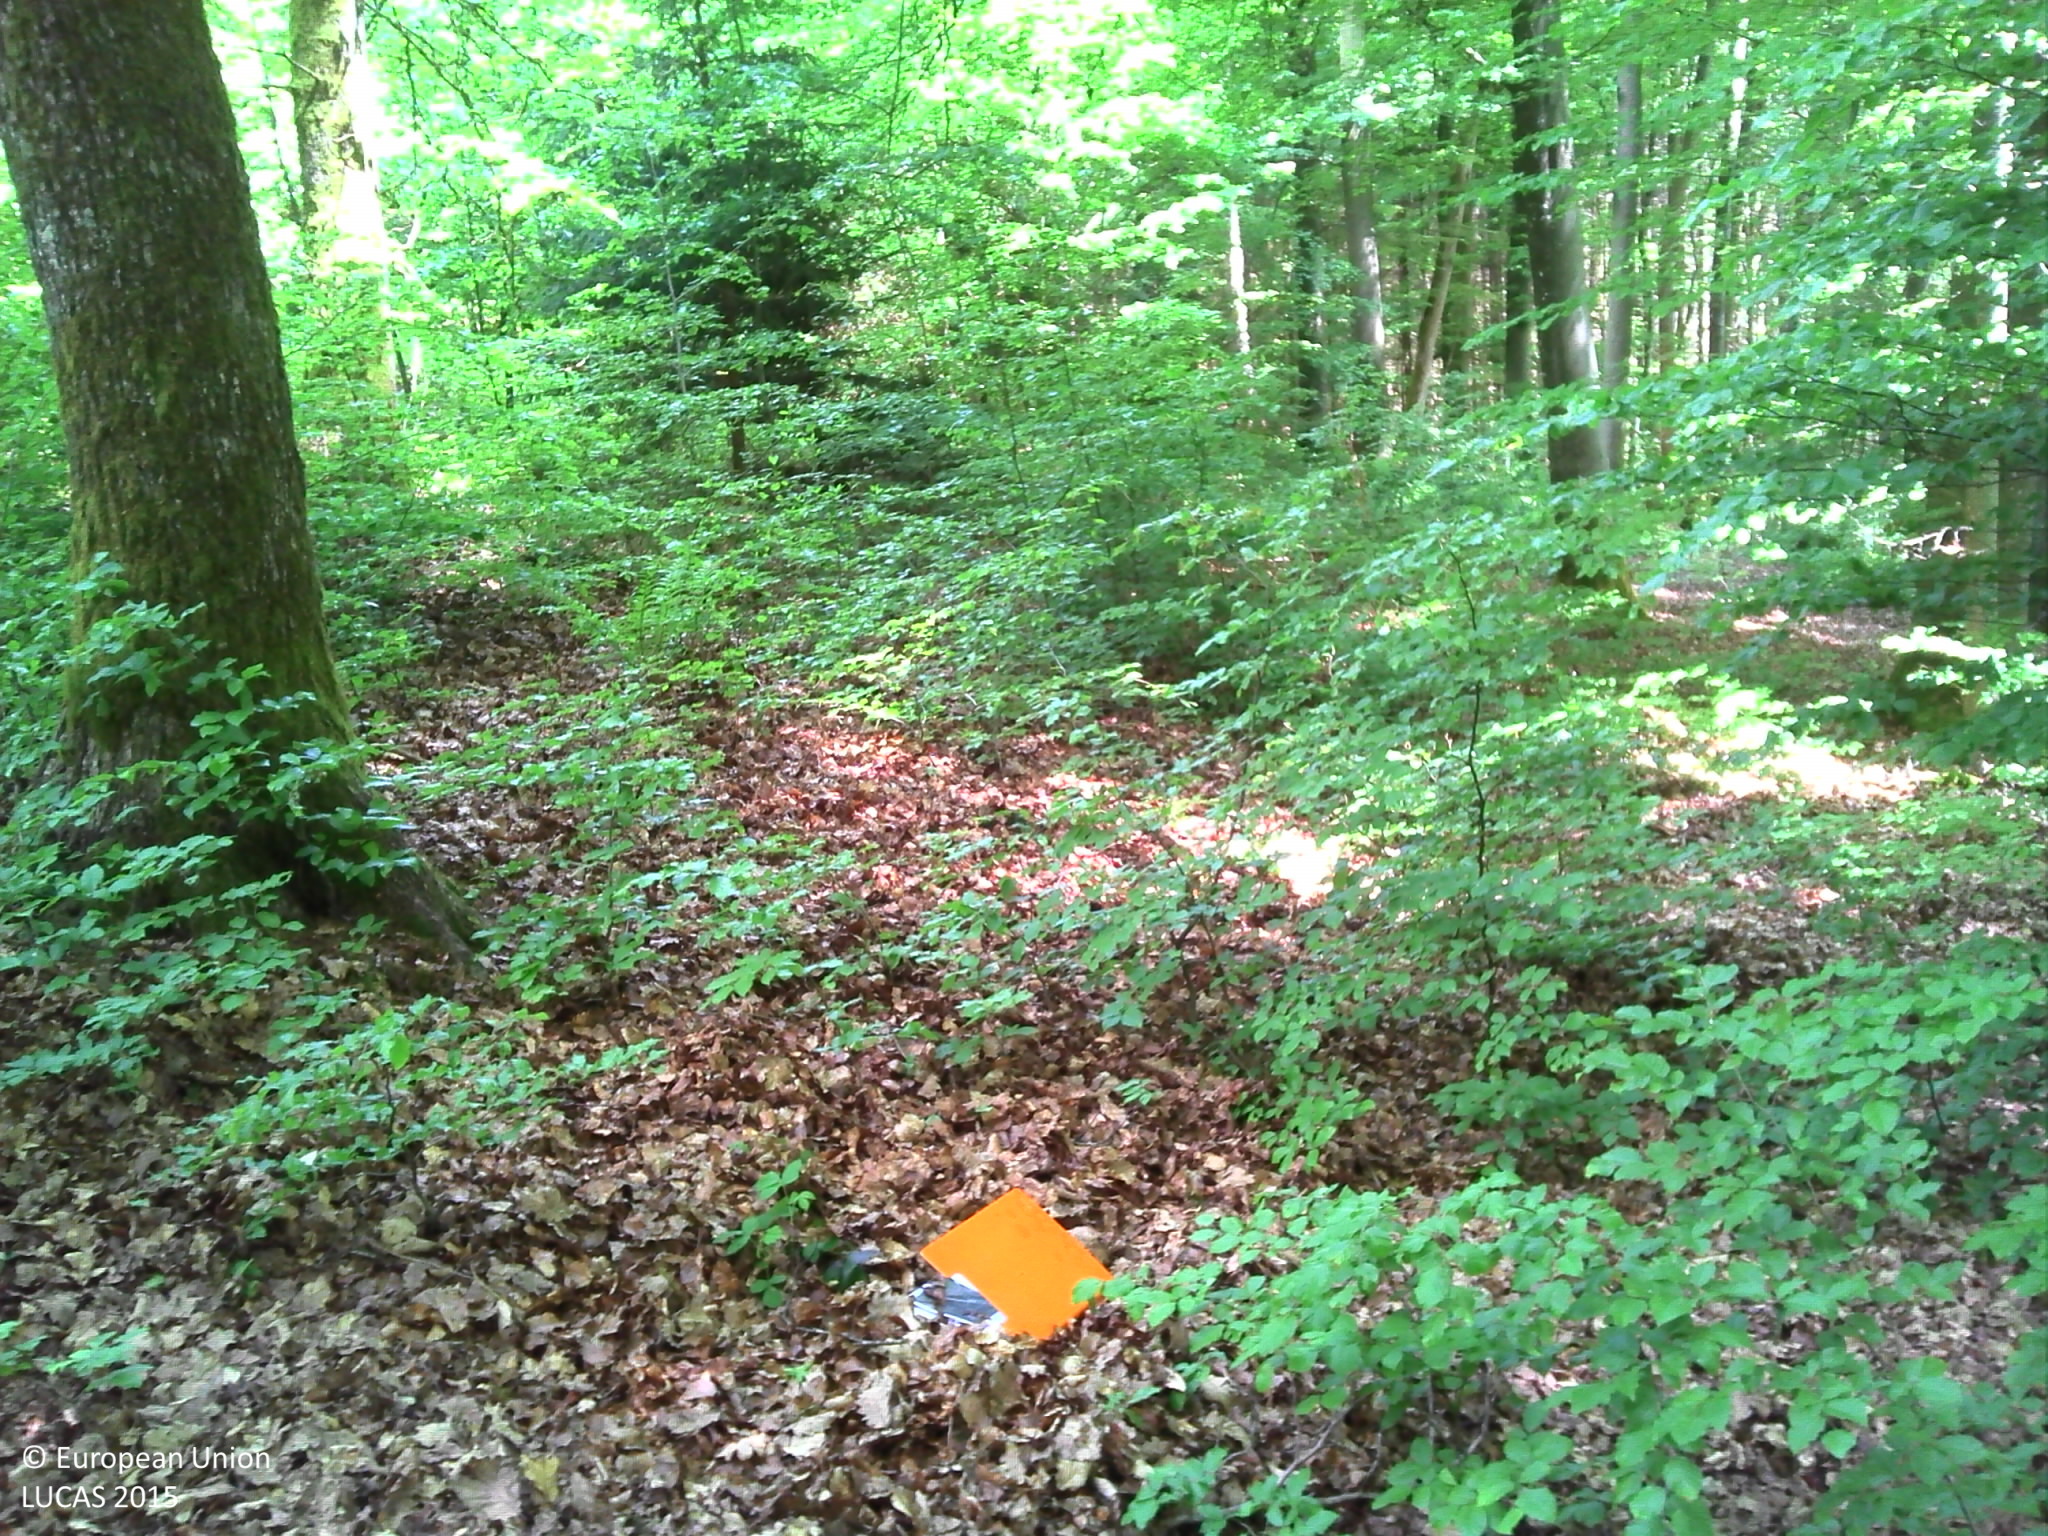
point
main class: Woodland
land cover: Broadleaved woodland
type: acidophilous oak and oak-birch forest
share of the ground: > 75 %
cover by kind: broadleaved forest trees 95 %, coniferous forest trees 5 %
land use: Forestry
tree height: > 5 m
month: May
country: LU
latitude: 49.6967
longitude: 5.9093
